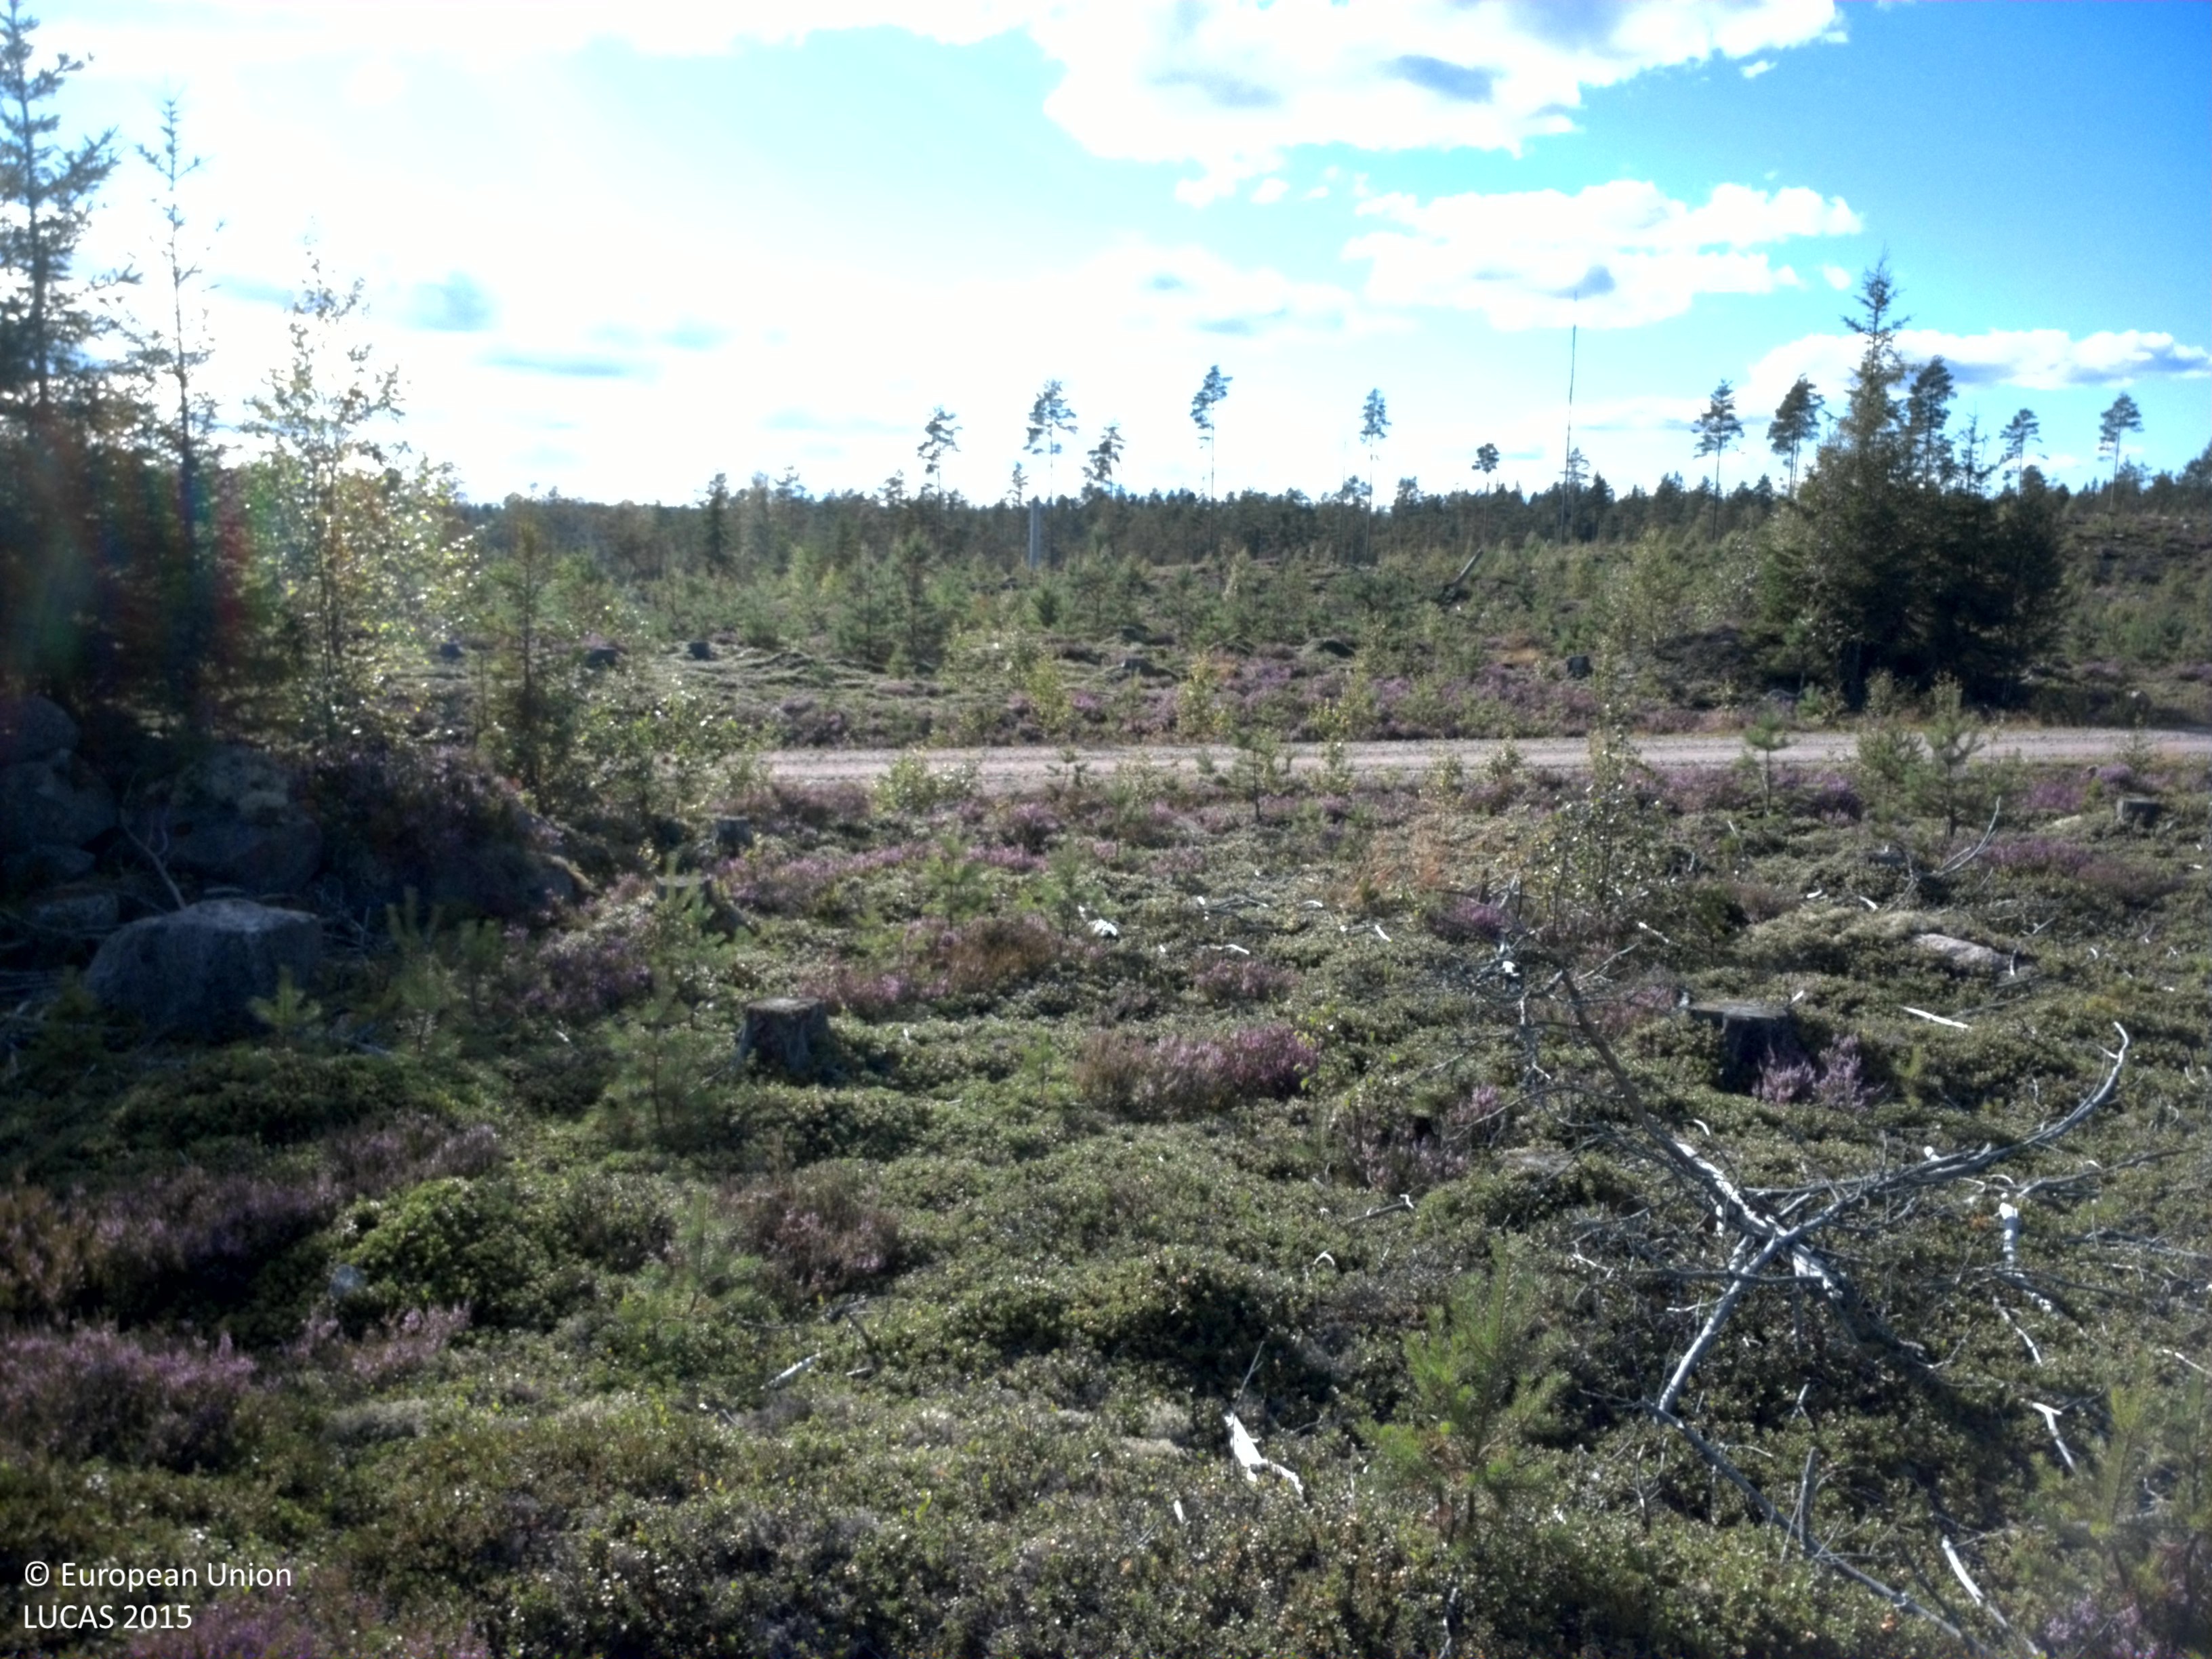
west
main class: Woodland
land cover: Pine dominated mixed woodland
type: boreal forest
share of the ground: 25 - 50 %
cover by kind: shrubs 45 %, lichens and mosses 20 %, coniferous forest trees 15 %, broadleaved forest trees 15 %, herbaceous plants 5 %
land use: Forestry
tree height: < 5 m
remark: Clear cut
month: August
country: SE
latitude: 60.2441
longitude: 13.5487
